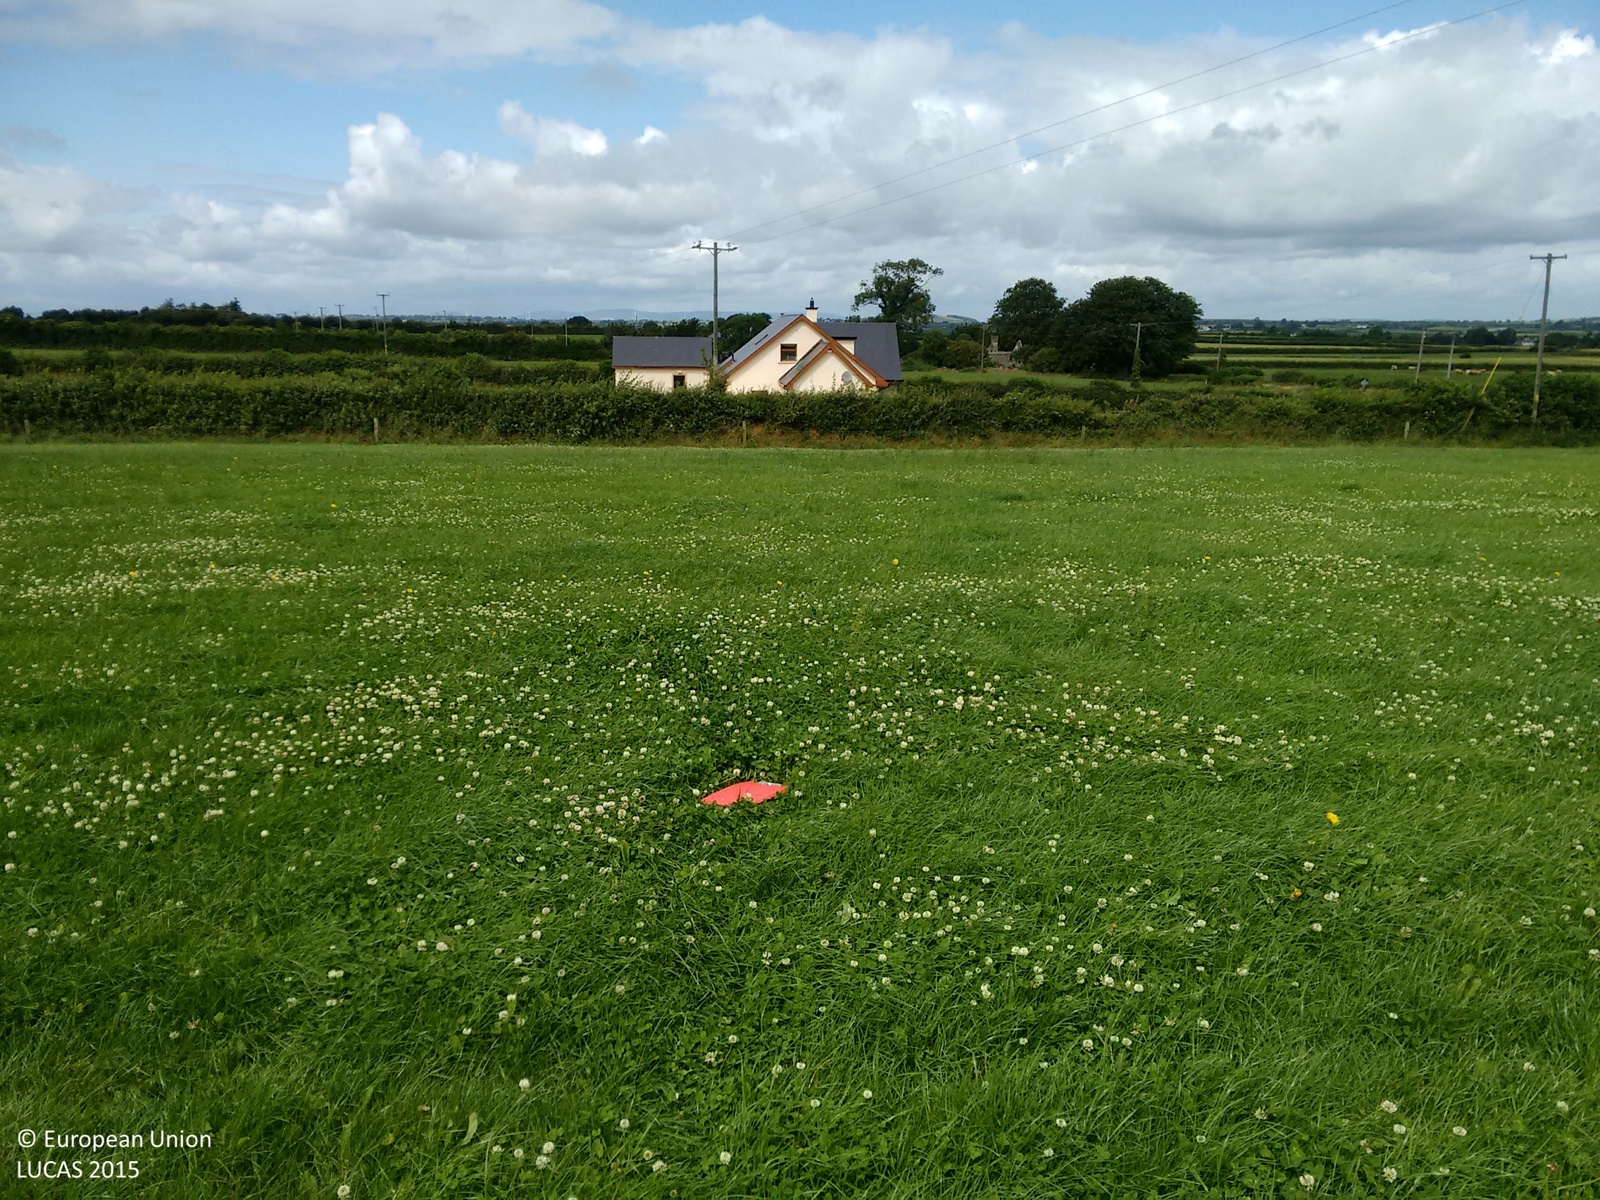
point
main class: Grassland
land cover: Grassland without tree/shrub cover
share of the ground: > 75 %
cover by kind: herbaceous plants 100 %
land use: Agriculture (excluding fallow land and kitchen gardens)
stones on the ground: < 10 %
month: July
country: IE
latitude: 52.7734
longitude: -7.5171
